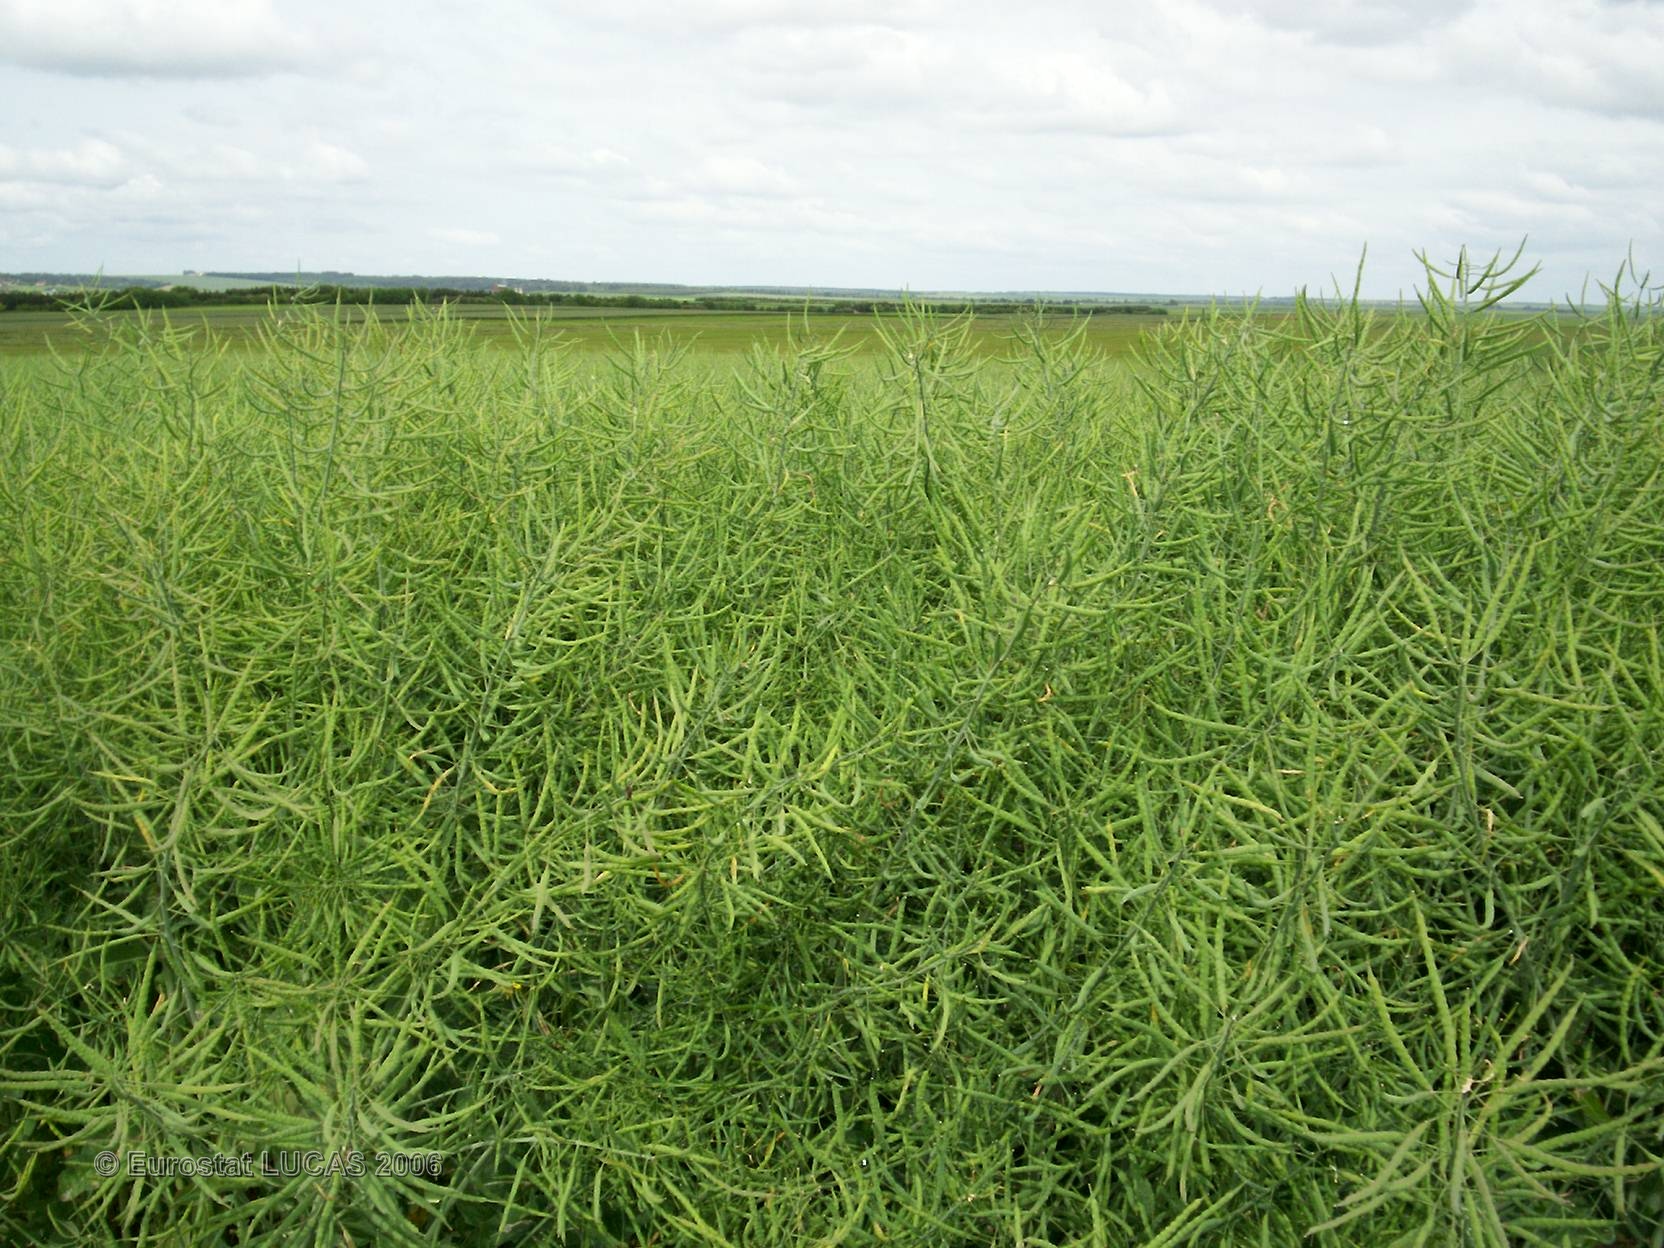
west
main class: Cropland
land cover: Rape and turnip rape
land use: Agriculture (excluding fallow land and kitchen gardens)
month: April
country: FR
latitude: 48.3304
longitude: 3.9935
